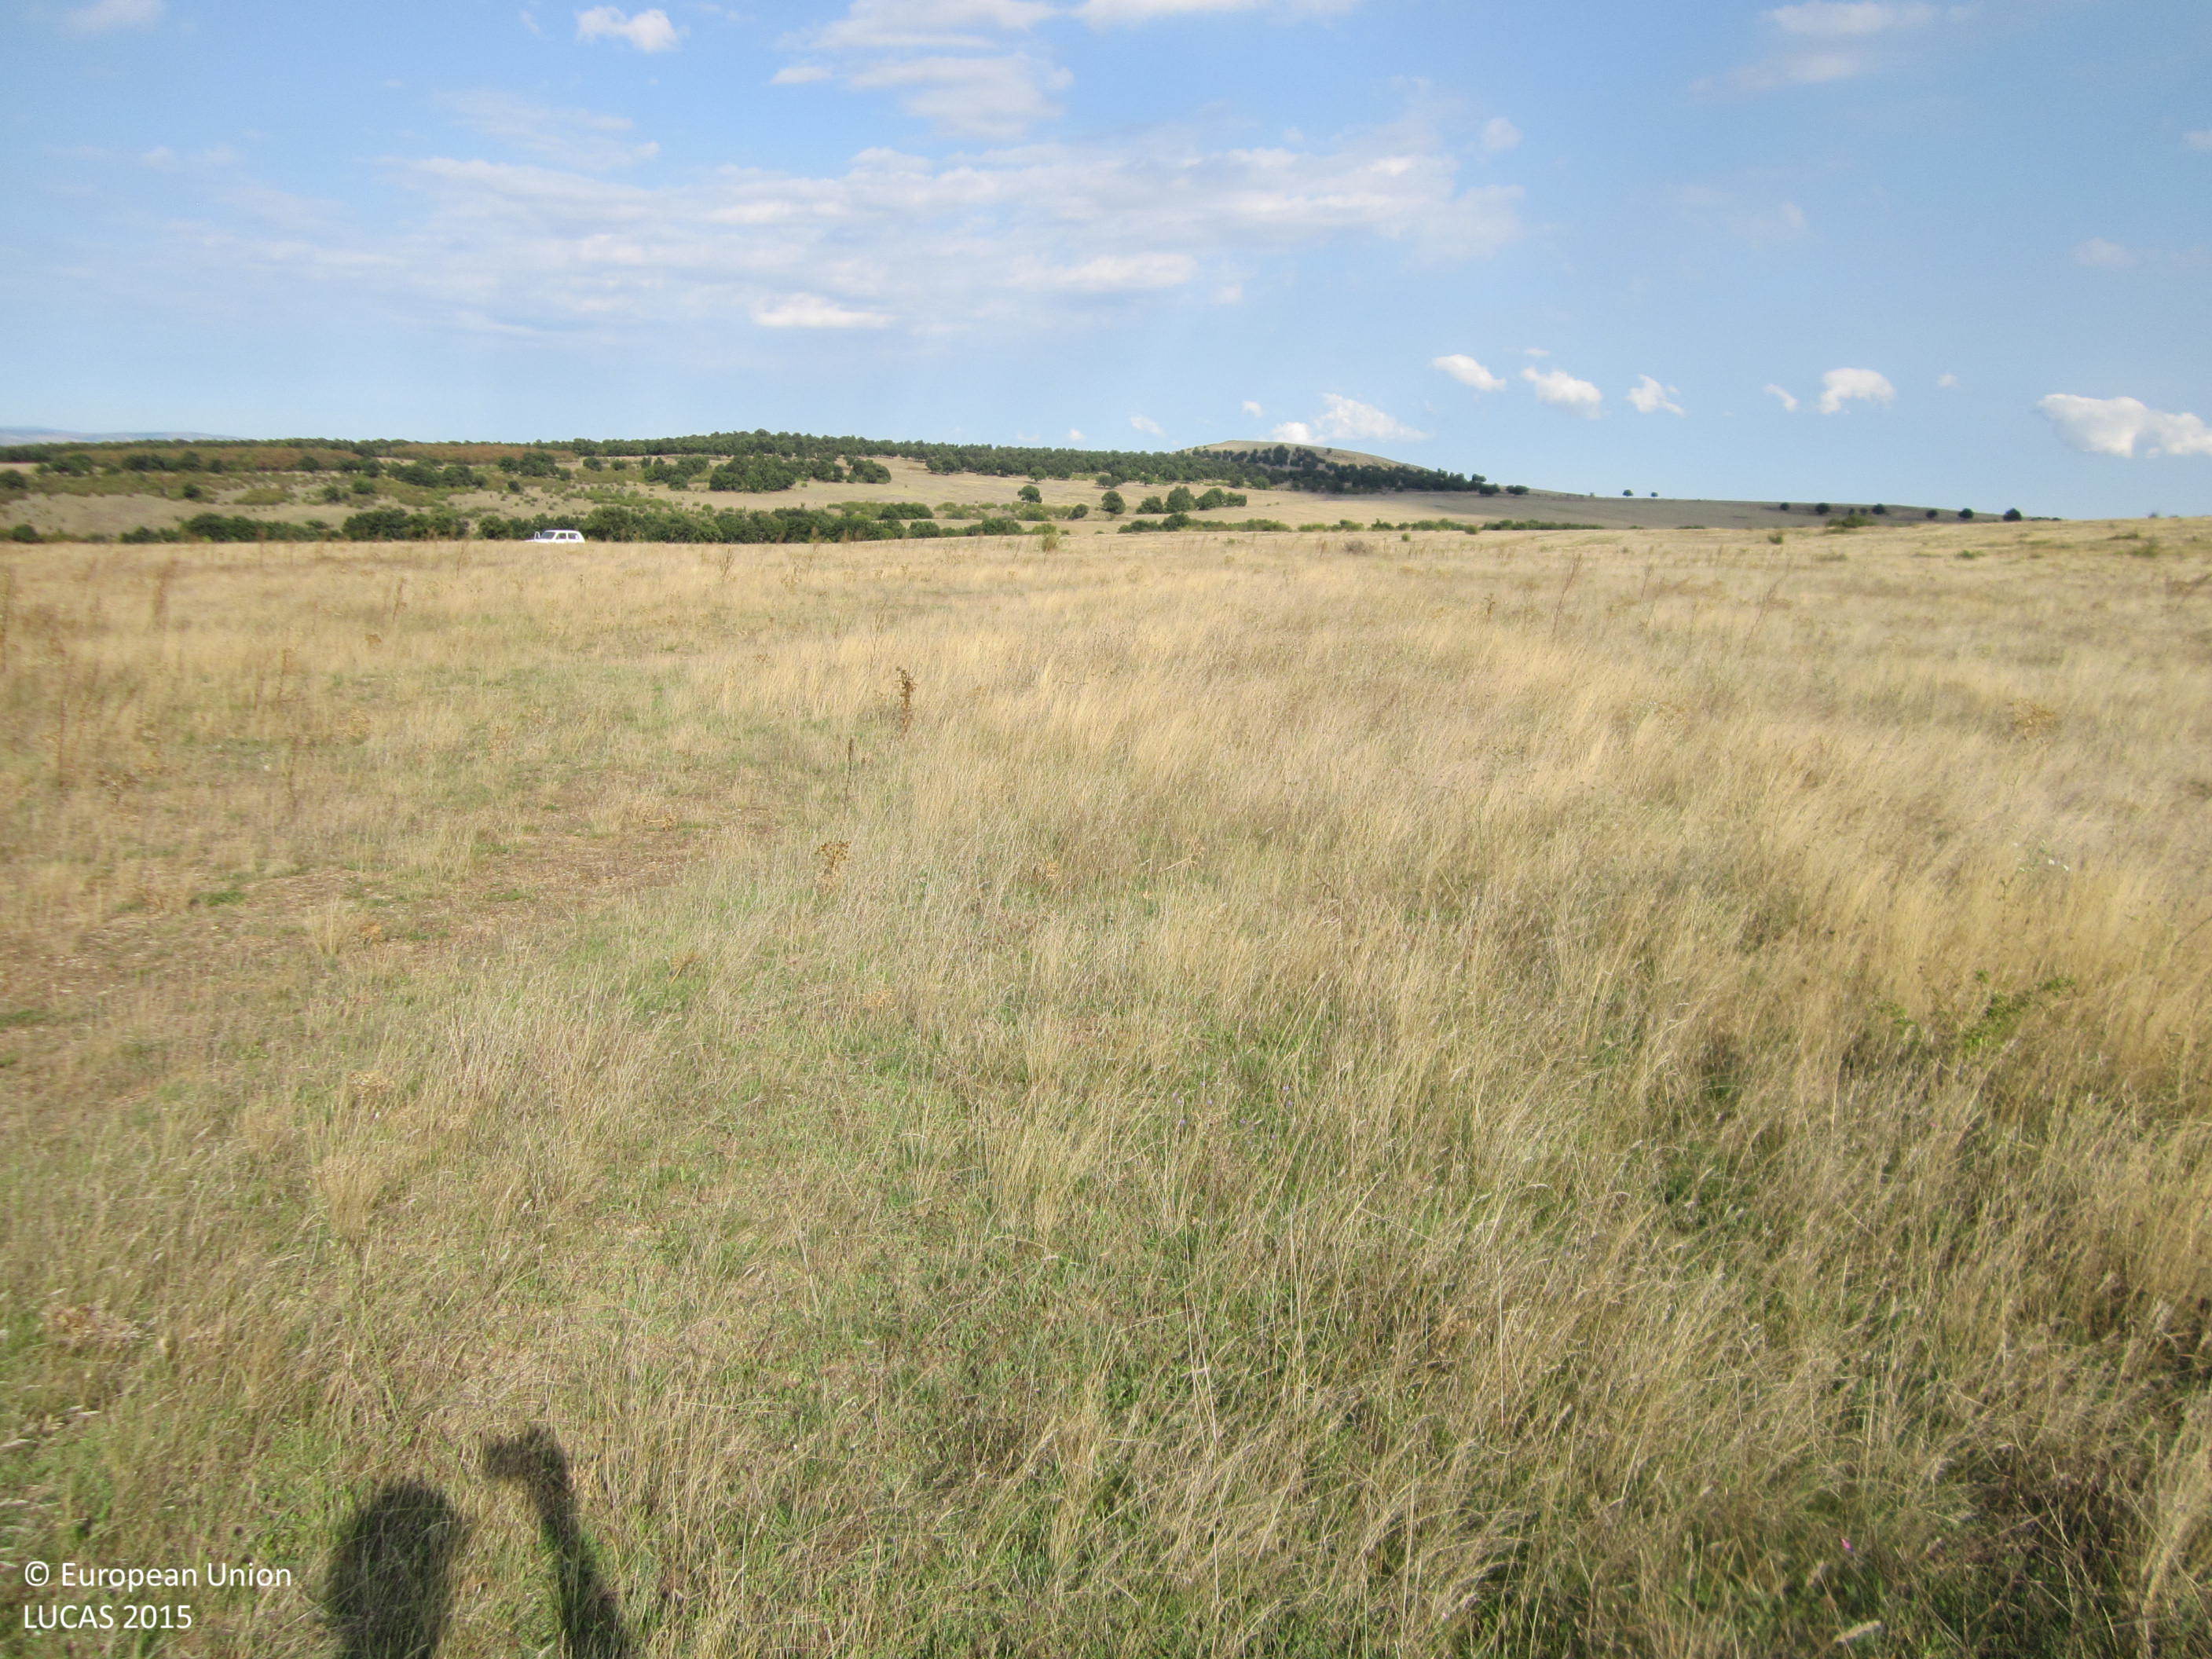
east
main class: Grassland
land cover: Grassland with sparse tree/shrub cover
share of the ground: > 75 %
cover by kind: herbaceous plants 90 %, broadleaved forest trees 5 %, shrubs 5 %
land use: Agriculture (excluding fallow land and kitchen gardens)
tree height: < 5 m
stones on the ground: < 10 %
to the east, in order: Grassland with sparse tree/shrub cover; Tracks; Grassland without tree/shrub cover; Ditches and canals; Grassland without tree/shrub cover
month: September
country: BG
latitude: 42.6464
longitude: 27.0746
